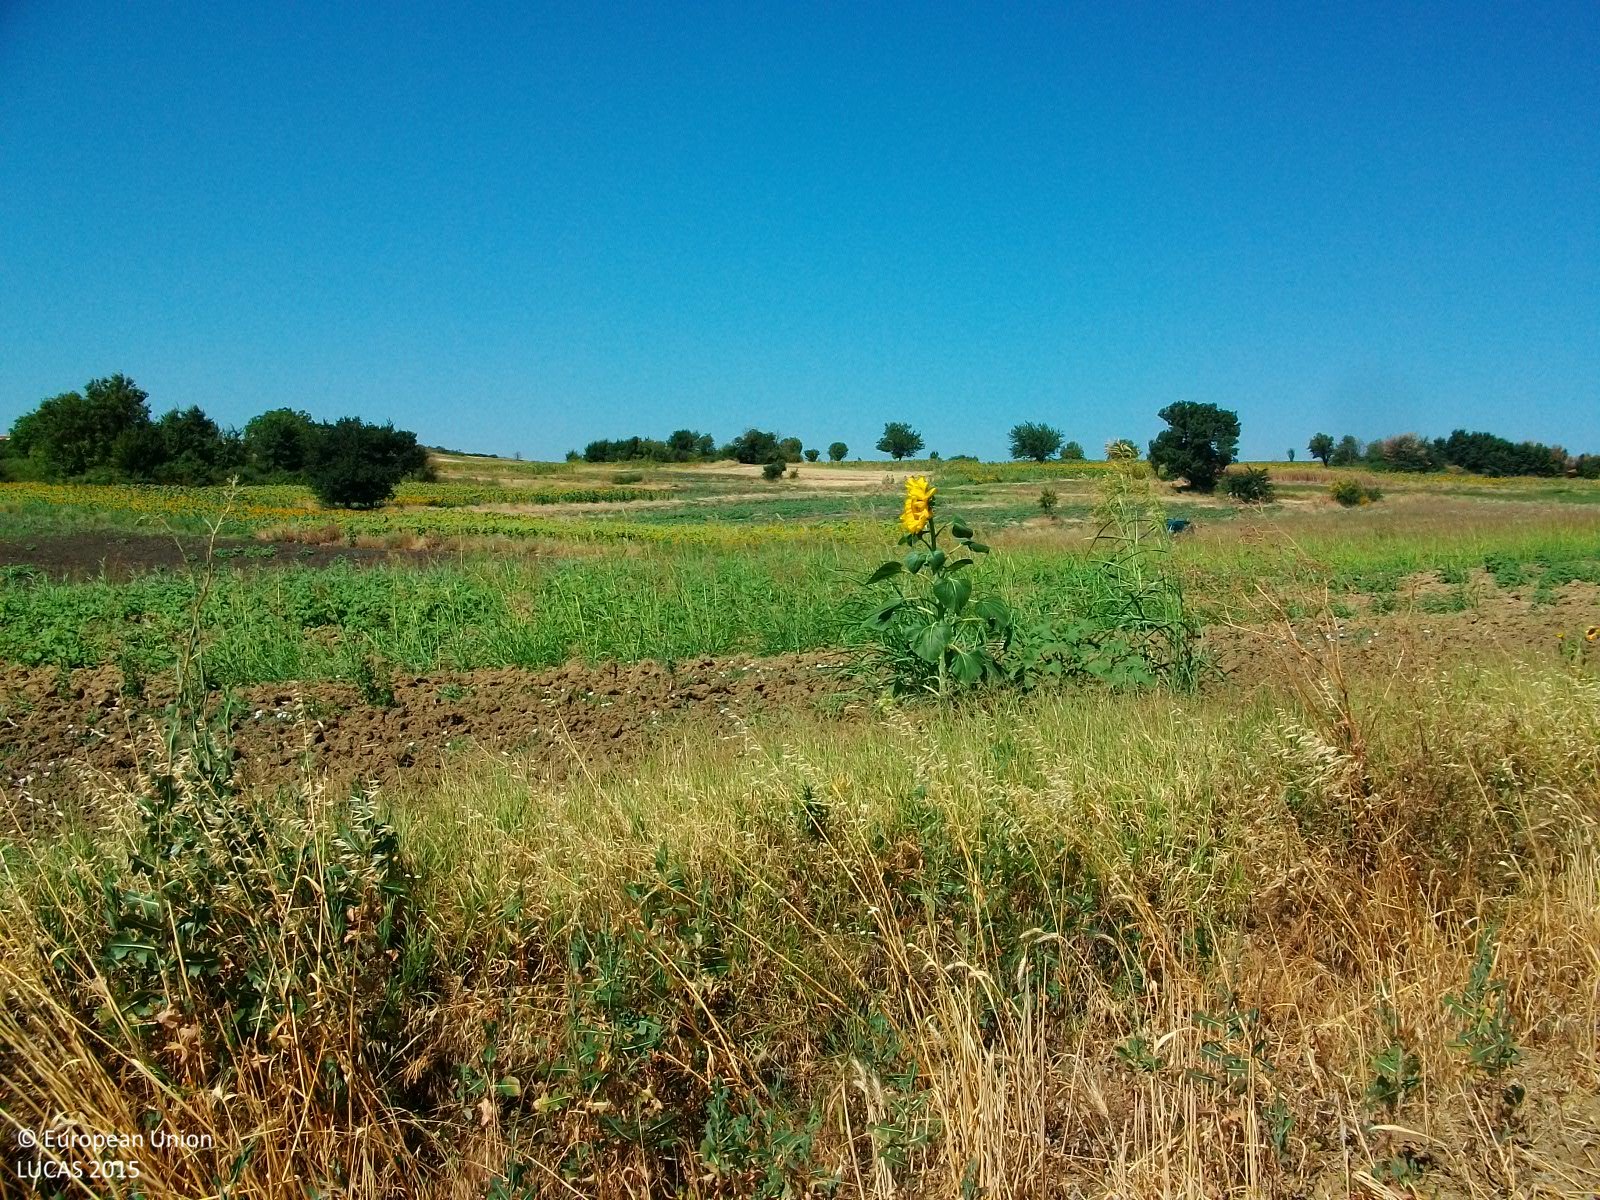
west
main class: Cropland
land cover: Common wheat
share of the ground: > 75 %
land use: Agriculture (excluding fallow land and kitchen gardens)
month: July
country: GR
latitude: 41.5234
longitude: 26.3129
